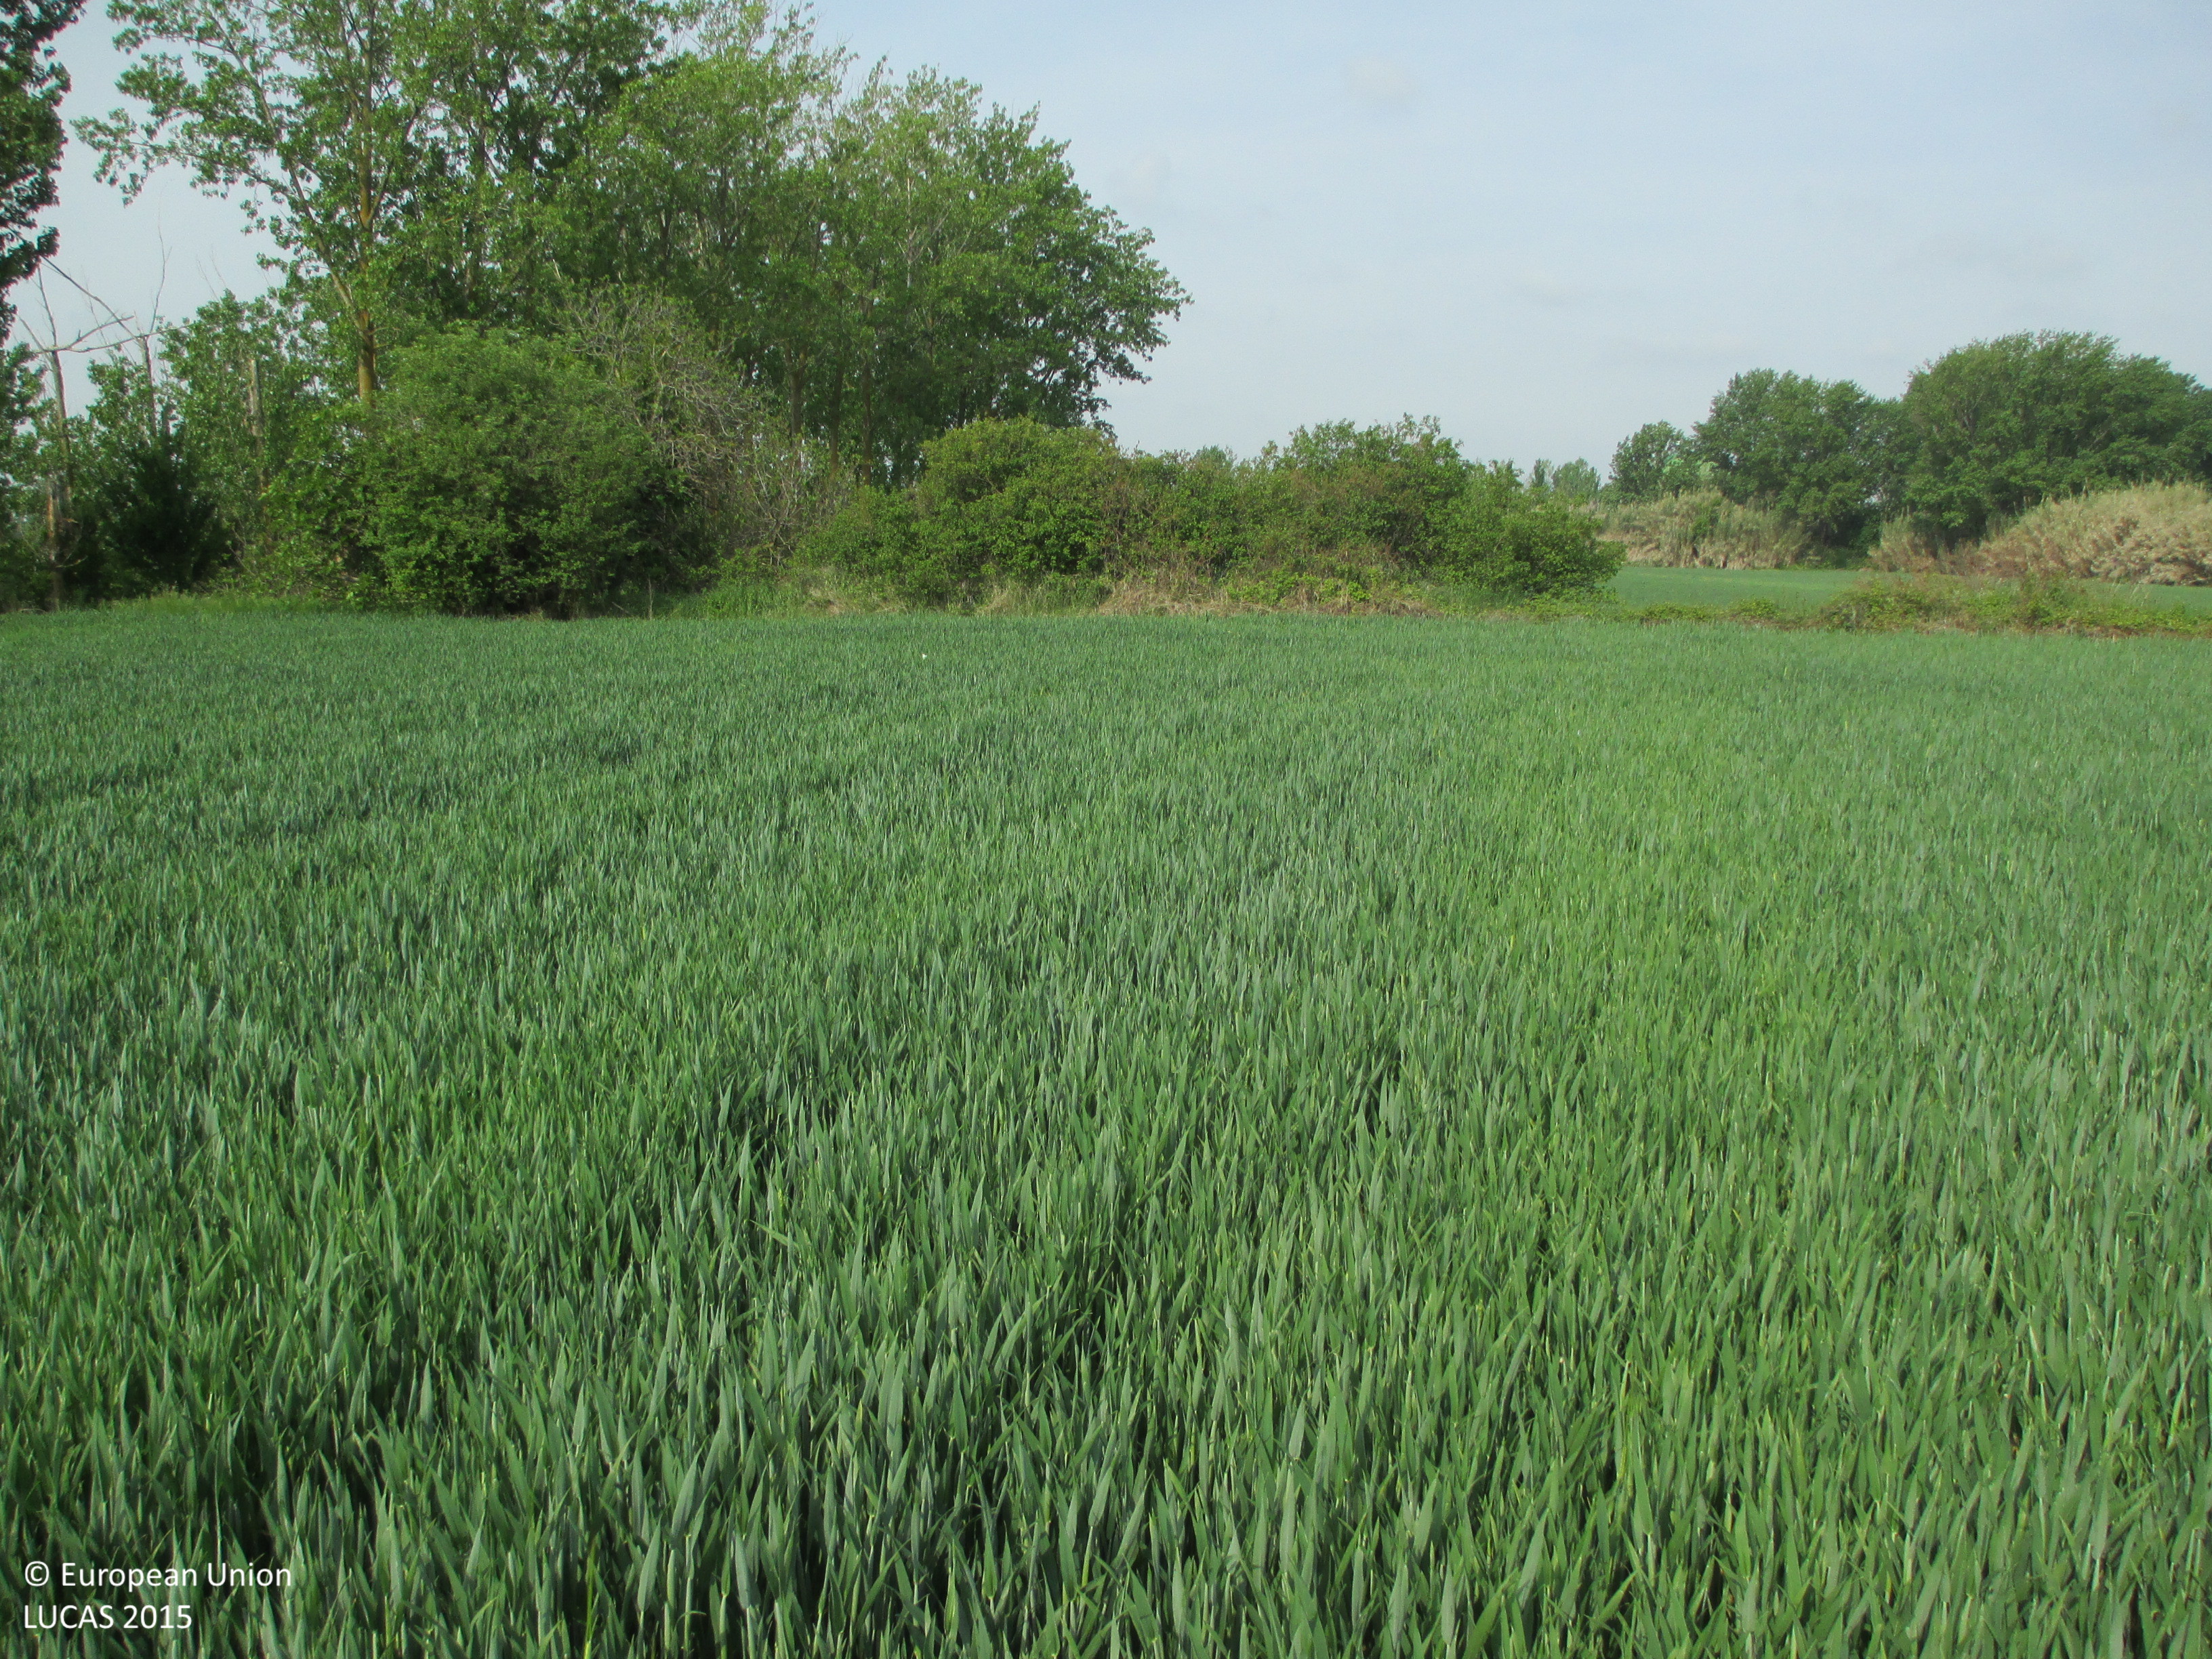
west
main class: Cropland
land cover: Durum wheat
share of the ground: > 75 %
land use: Agriculture (excluding fallow land and kitchen gardens)
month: April
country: ES
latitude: 42.1185
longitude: -0.3879
